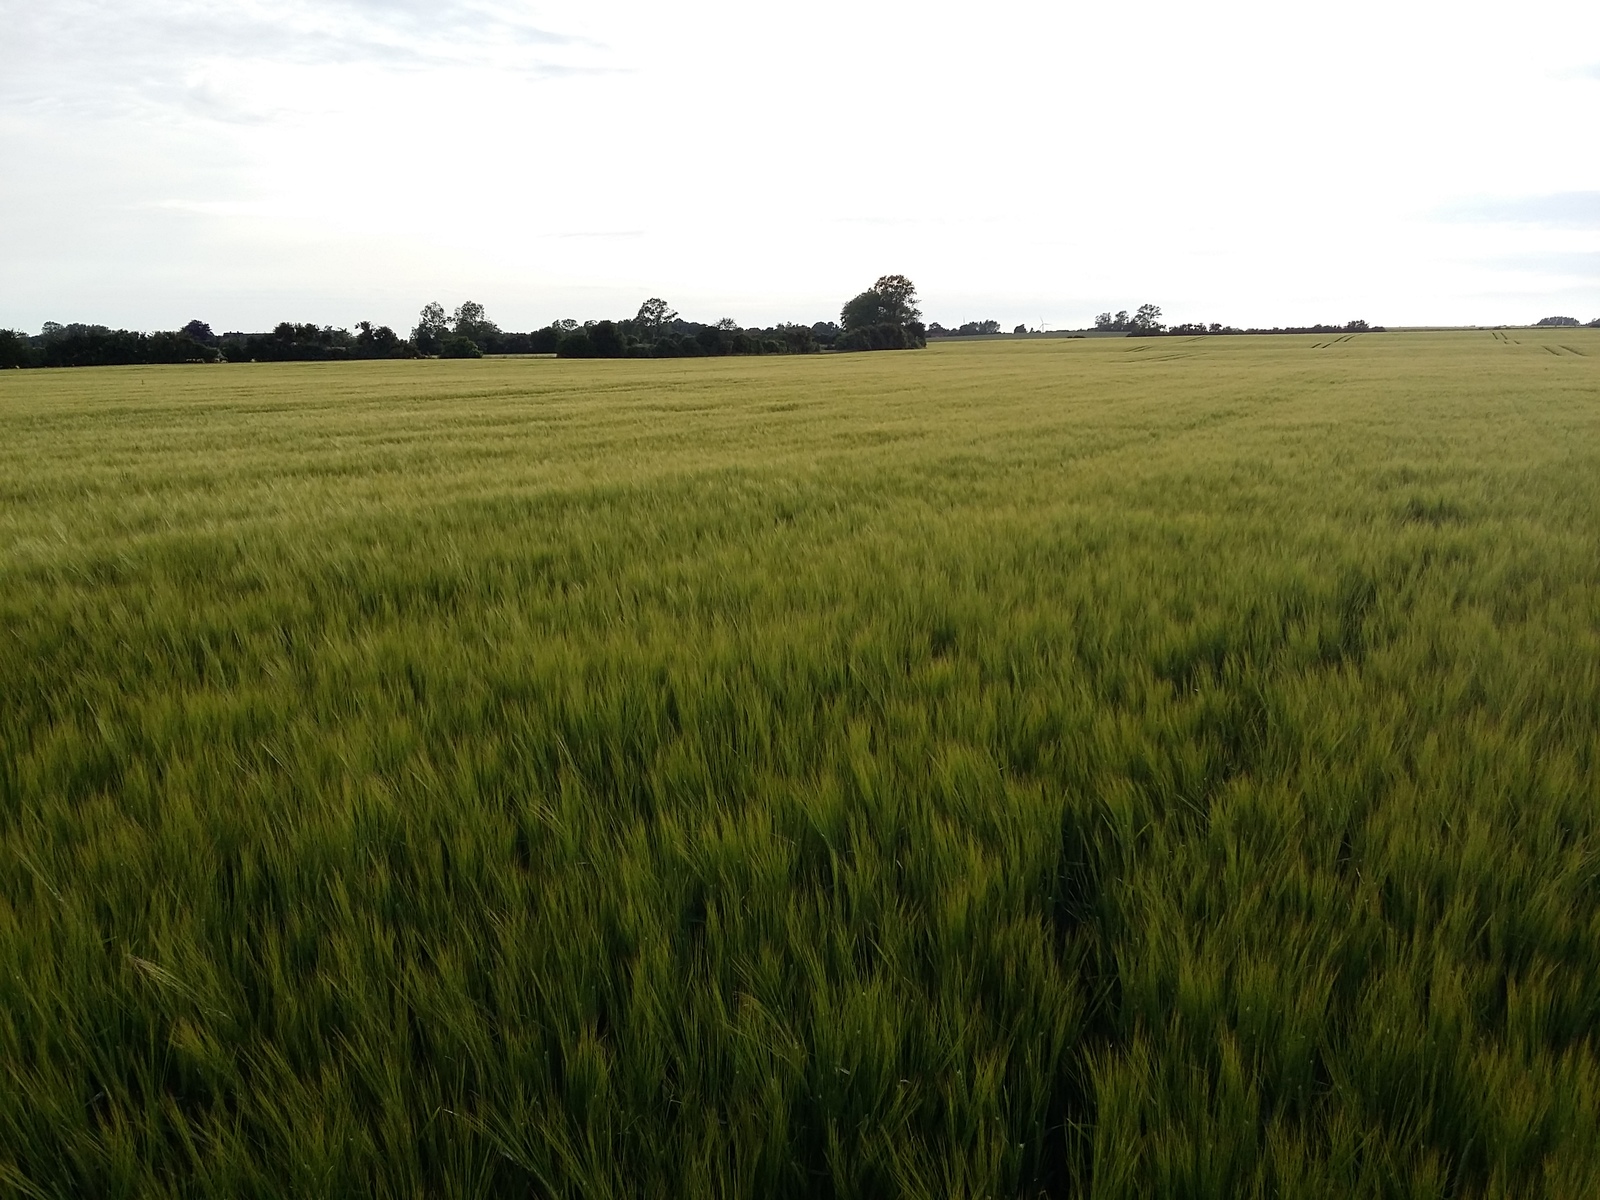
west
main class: Cropland
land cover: Barley
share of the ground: > 75 %
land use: Agriculture (excluding fallow land and kitchen gardens)
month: June
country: DK
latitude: 54.7697
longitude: 12.0039
